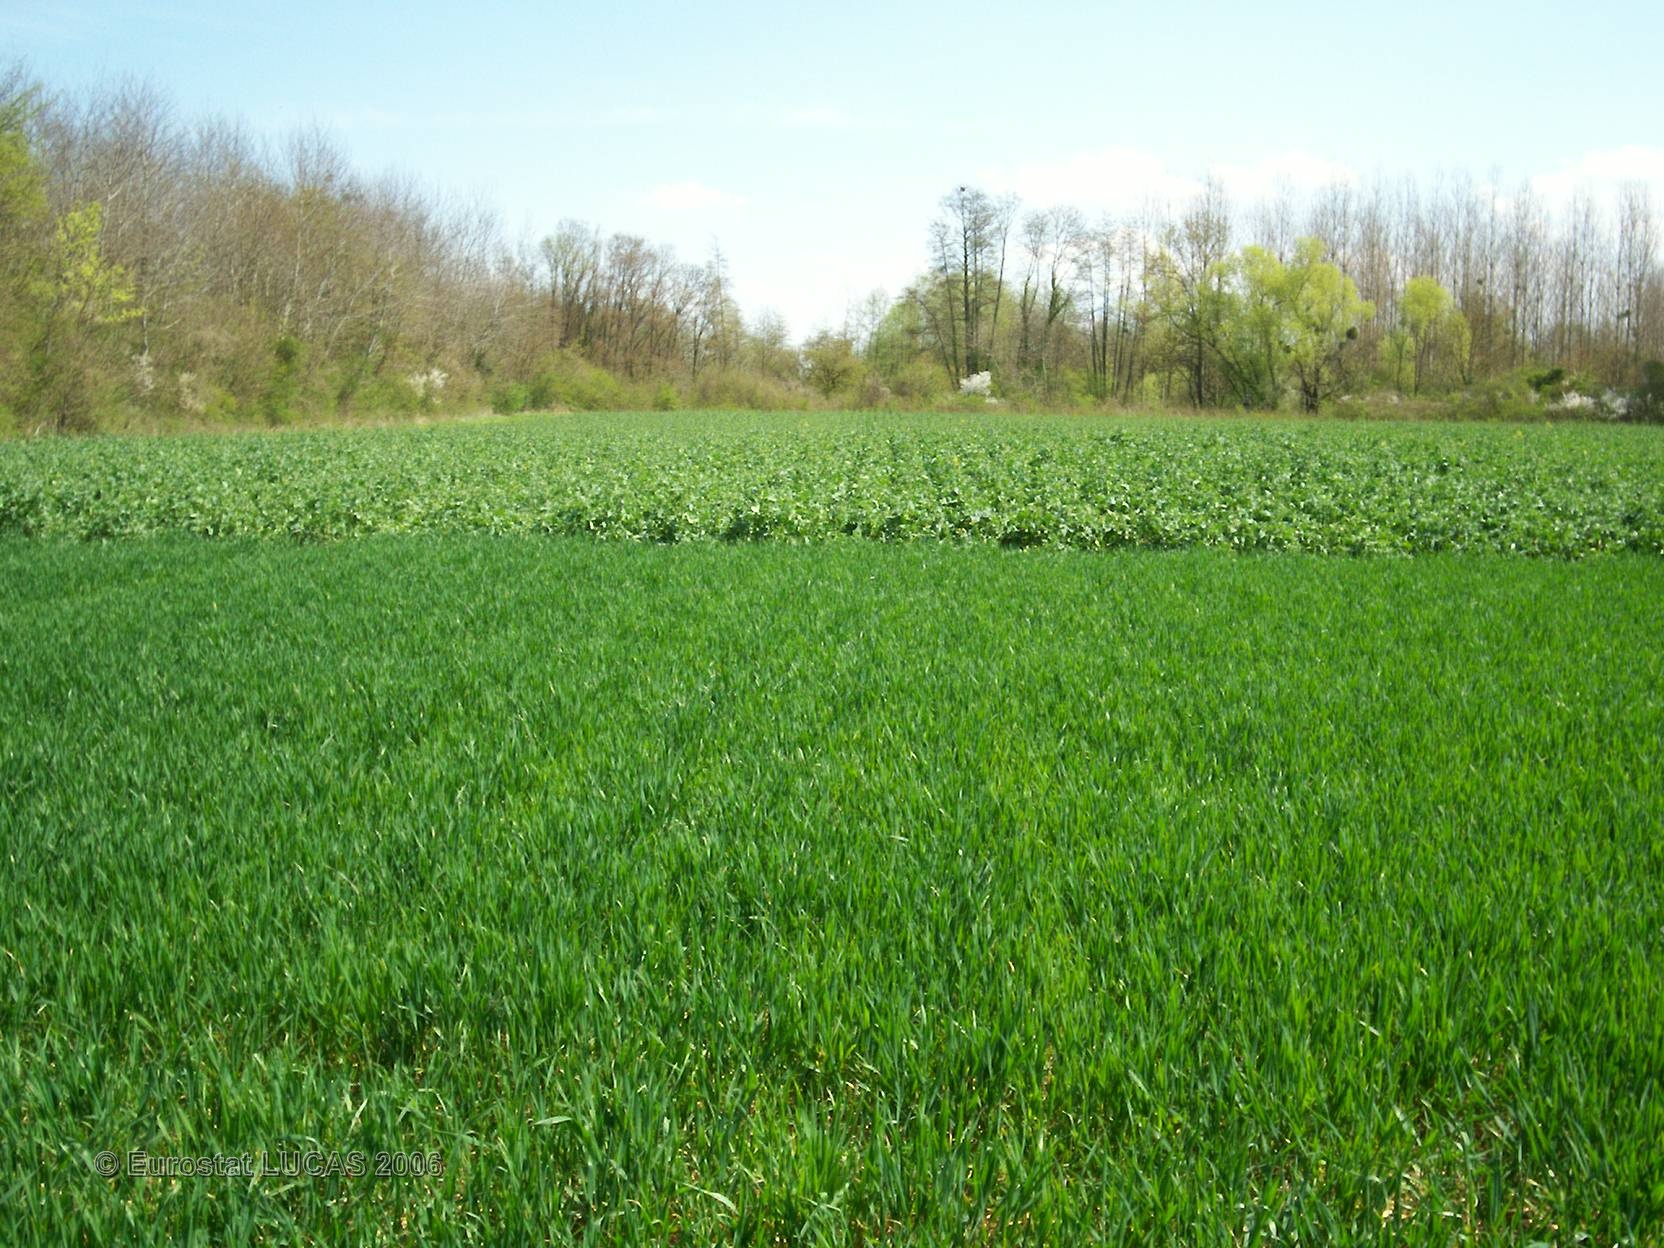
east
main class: Cropland
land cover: Common wheat
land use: Agriculture (excluding fallow land and kitchen gardens)
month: April
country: FR
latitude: 48.4440
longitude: 4.4409
